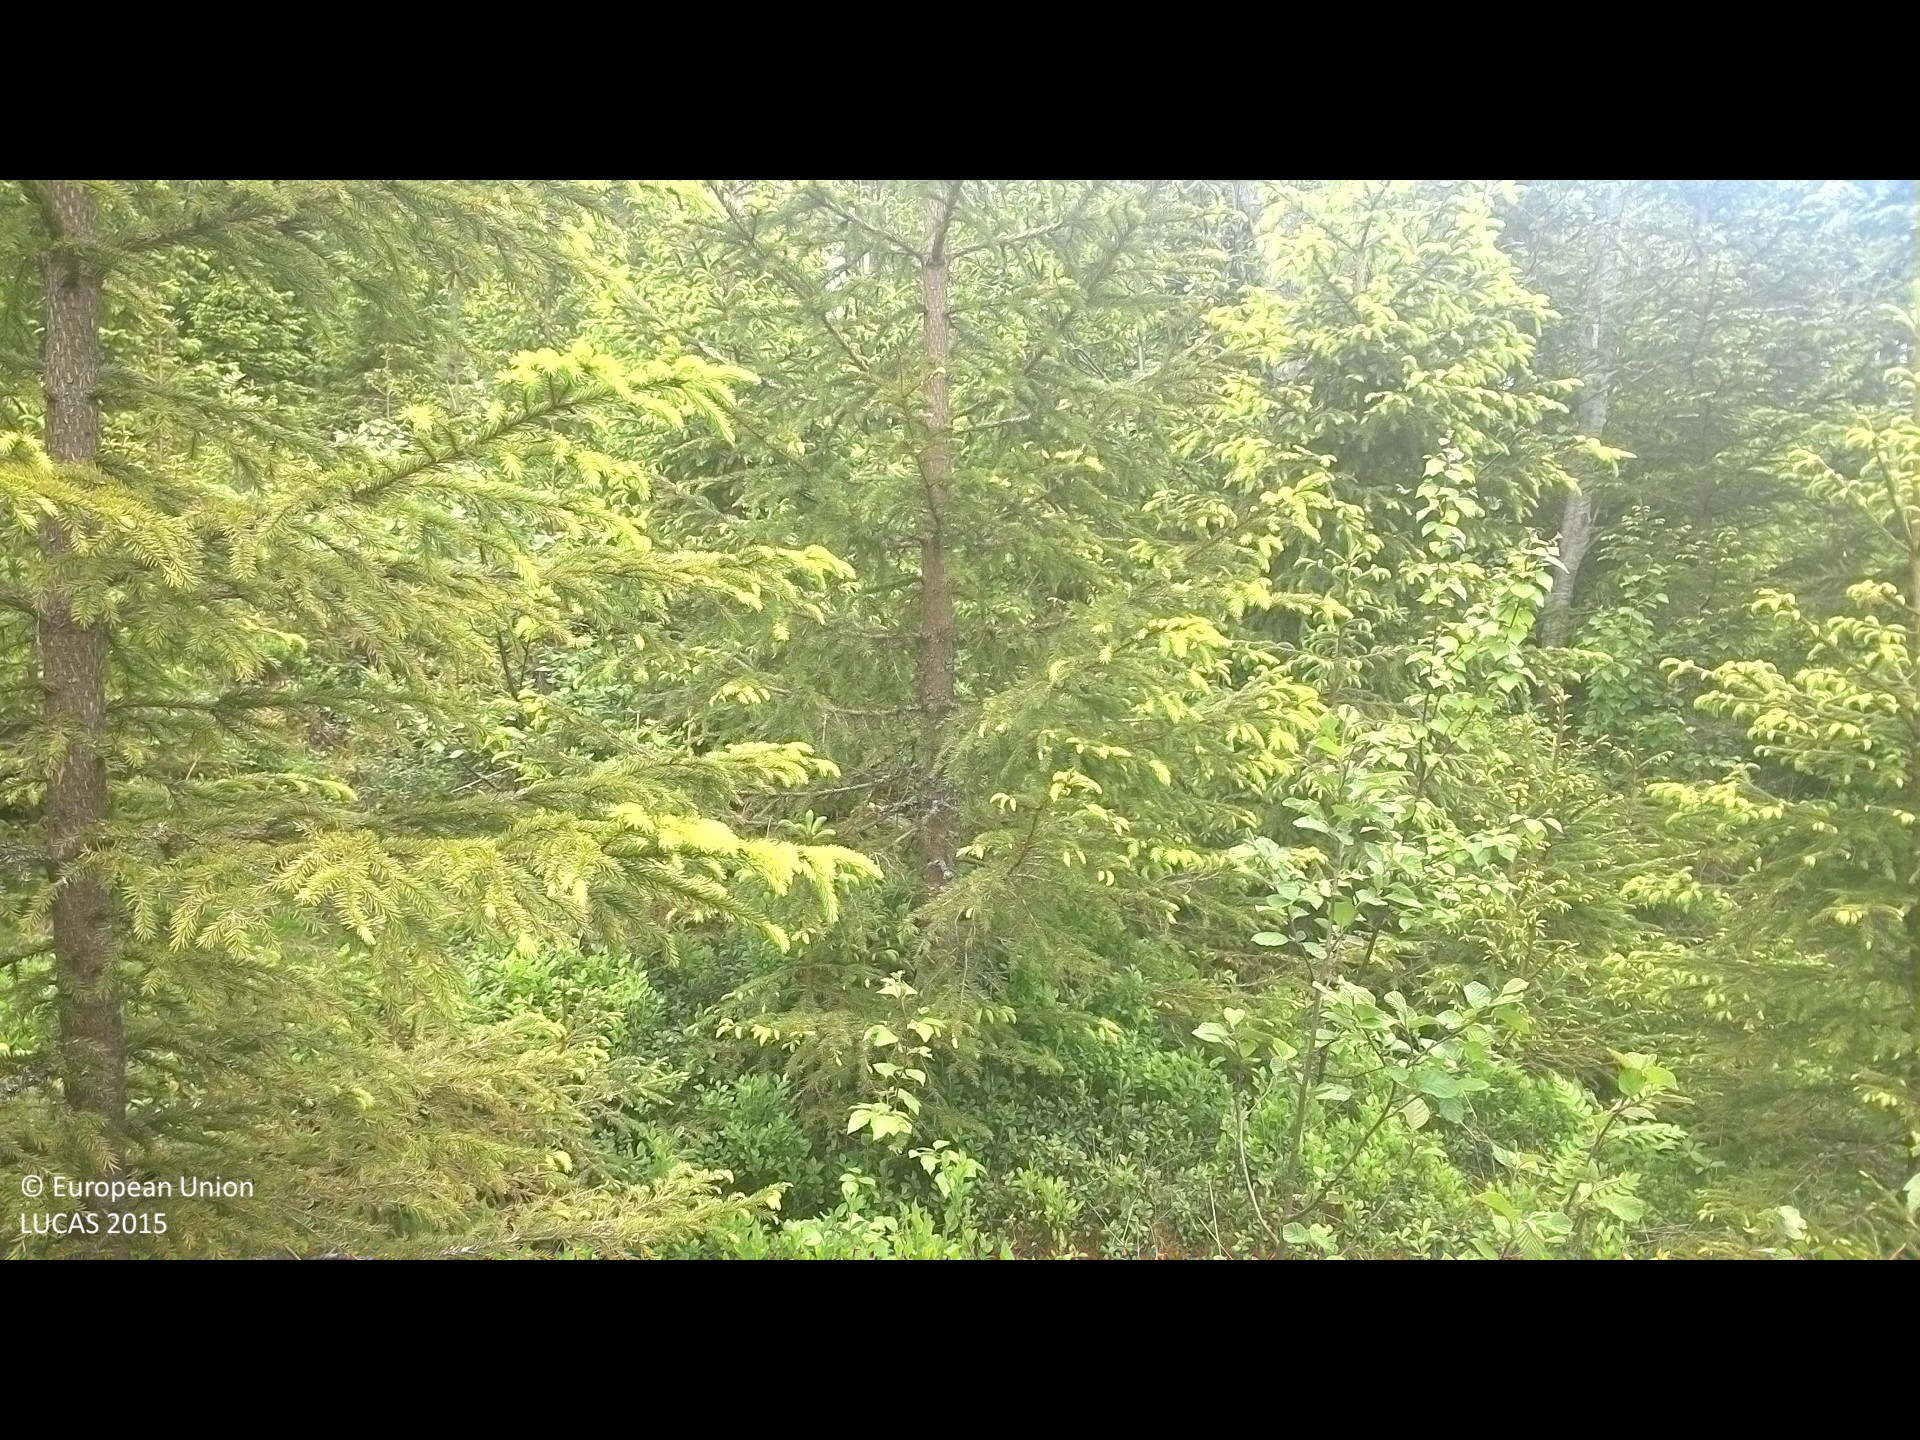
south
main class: Woodland
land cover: Spruce dominated mixed woodland
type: boreal forest
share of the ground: 25 - 50 %
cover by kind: coniferous forest trees 30 %, shrubs 30 %, lichens and mosses 25 %, broadleaved forest trees 15 %
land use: Forestry
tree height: < 5 m
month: June
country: SE
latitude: 61.9917
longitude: 16.7202
